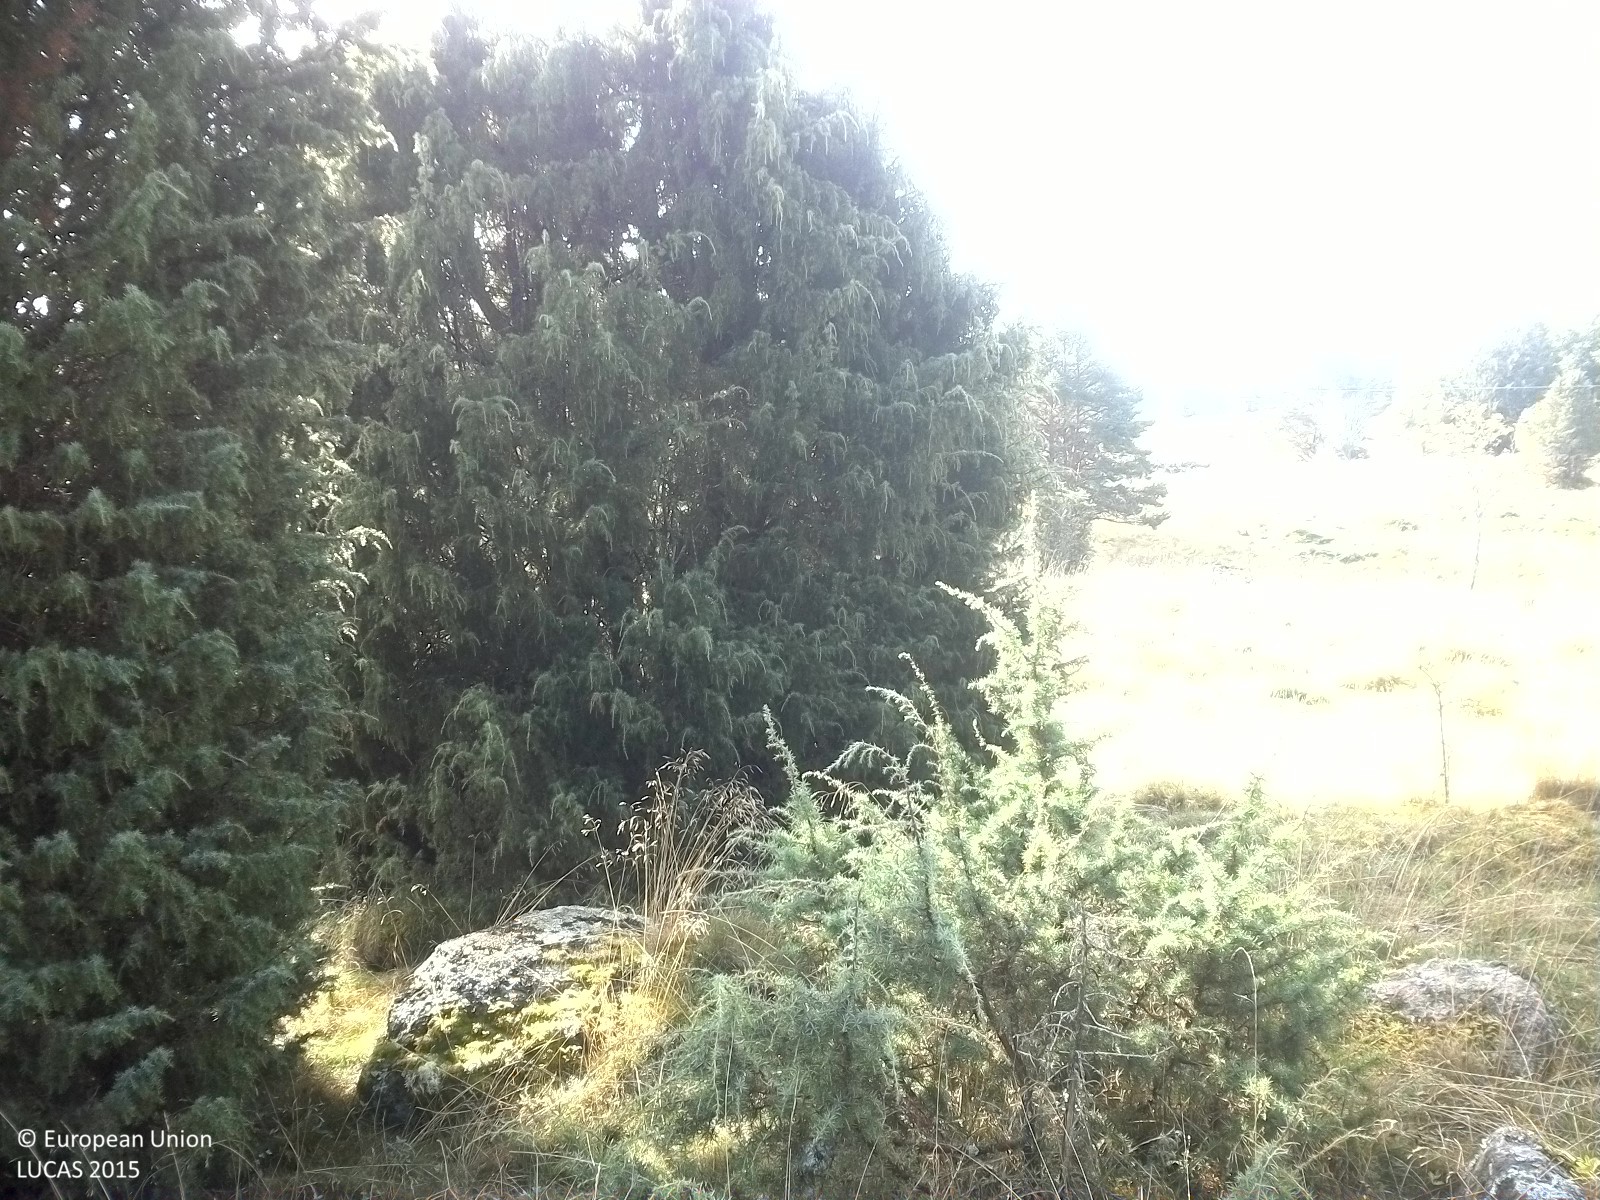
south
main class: Grassland
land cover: Grassland with sparse tree/shrub cover
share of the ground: > 75 %
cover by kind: herbaceous plants 90 %, broadleaved forest trees 5 %, shrubs 5 %
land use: Agriculture (excluding fallow land and kitchen gardens)
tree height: > 5 m
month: September
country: SE
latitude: 58.5477
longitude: 16.5426
